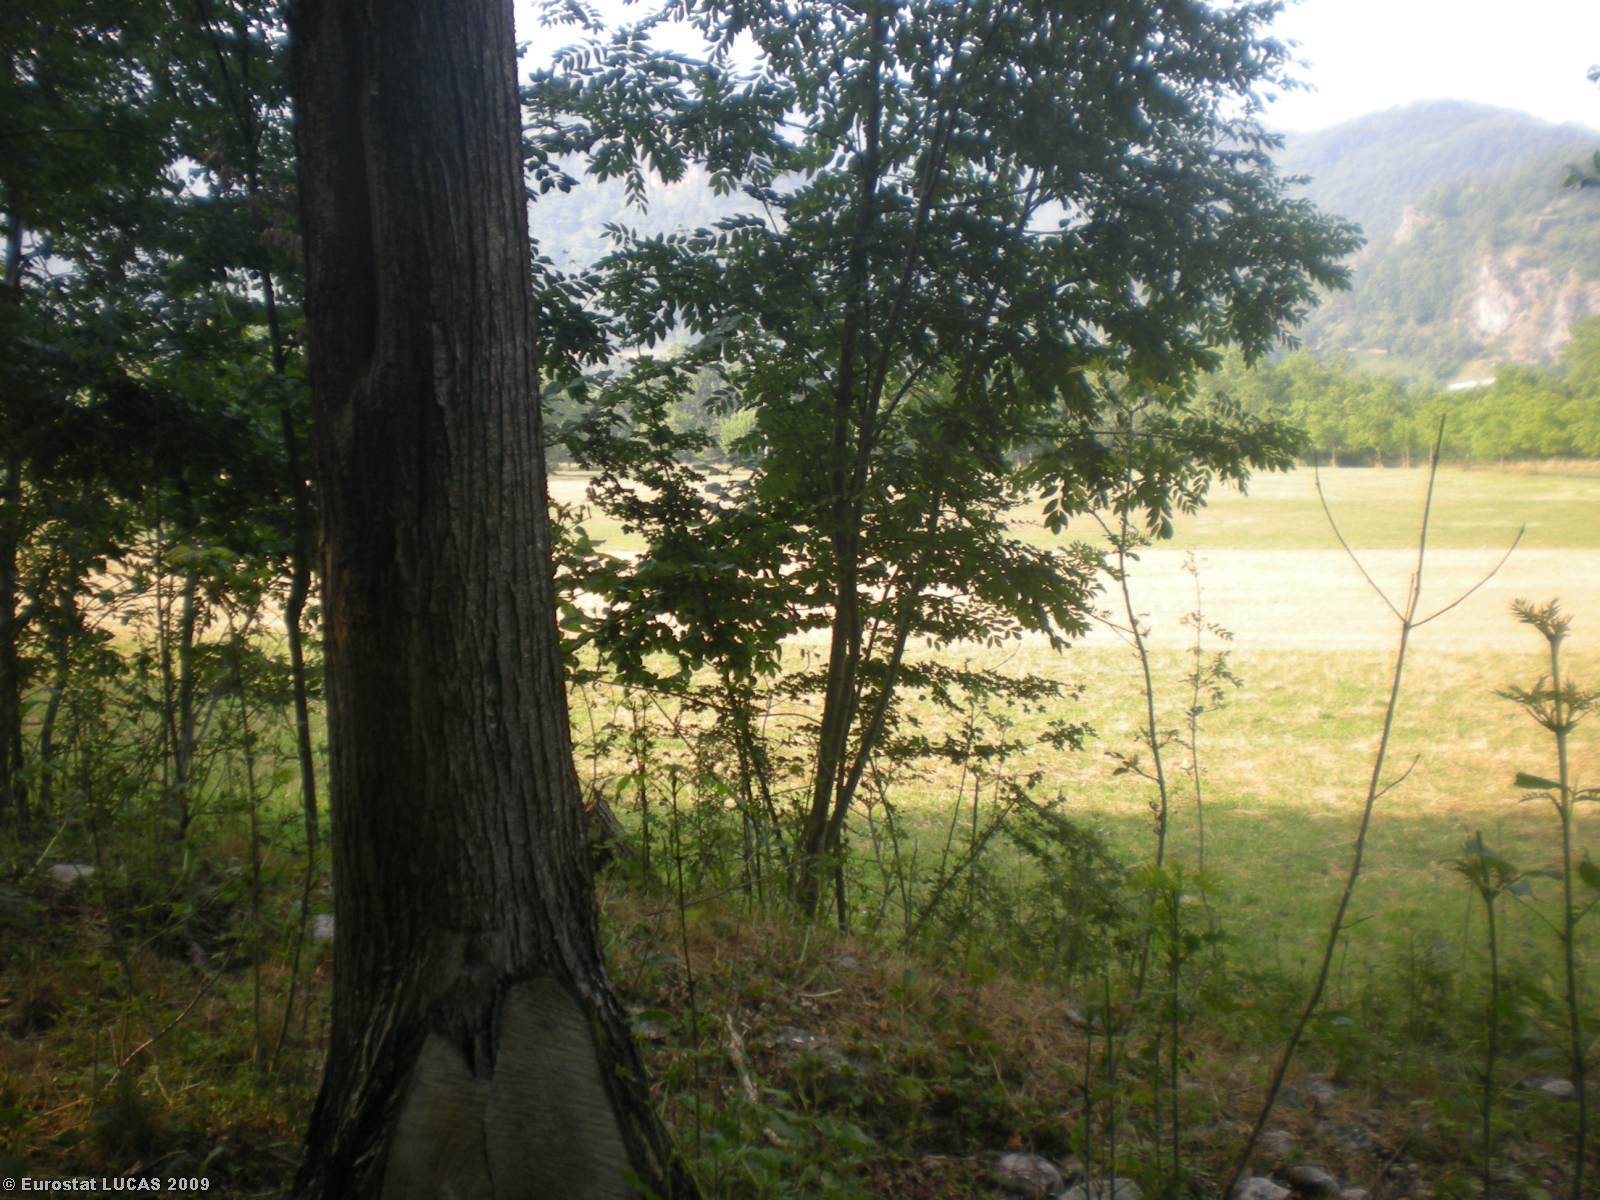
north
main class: Woodland
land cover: Broadleaved woodland
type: thermophilous deciduous forest
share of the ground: > 75 %
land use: Forestry
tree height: > 5 m
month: June
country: IT
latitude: 44.3369
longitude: 7.4343
